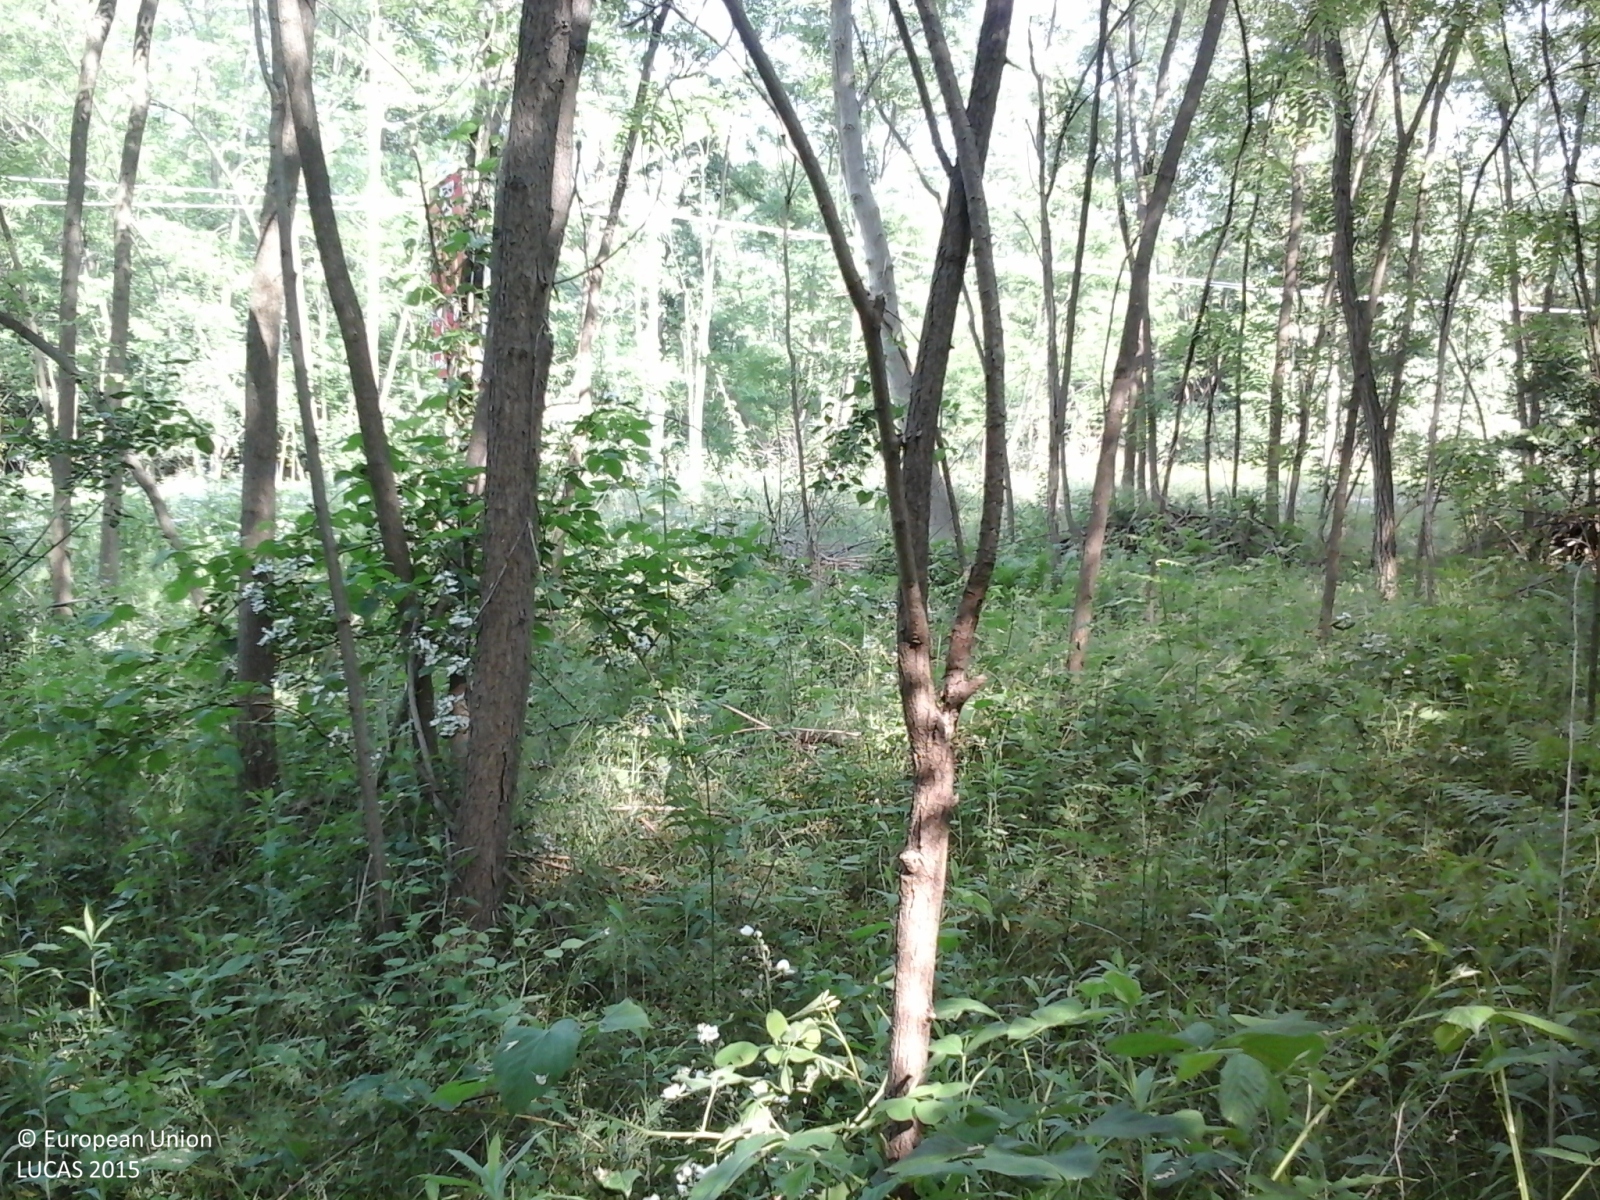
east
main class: Woodland
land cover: Broadleaved woodland
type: mesophytic deciduous forest
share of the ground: > 75 %
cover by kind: broadleaved forest trees 100 %
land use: Forestry
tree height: > 5 m
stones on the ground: < 10 %
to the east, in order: Broadleaved woodland; Grass margins; Paved roads, cycling and walking lanes; Grass margins; Broadleaved woodland; Tracks; Broadleaved woodland
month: May
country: IT
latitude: 45.5820
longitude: 8.3749
